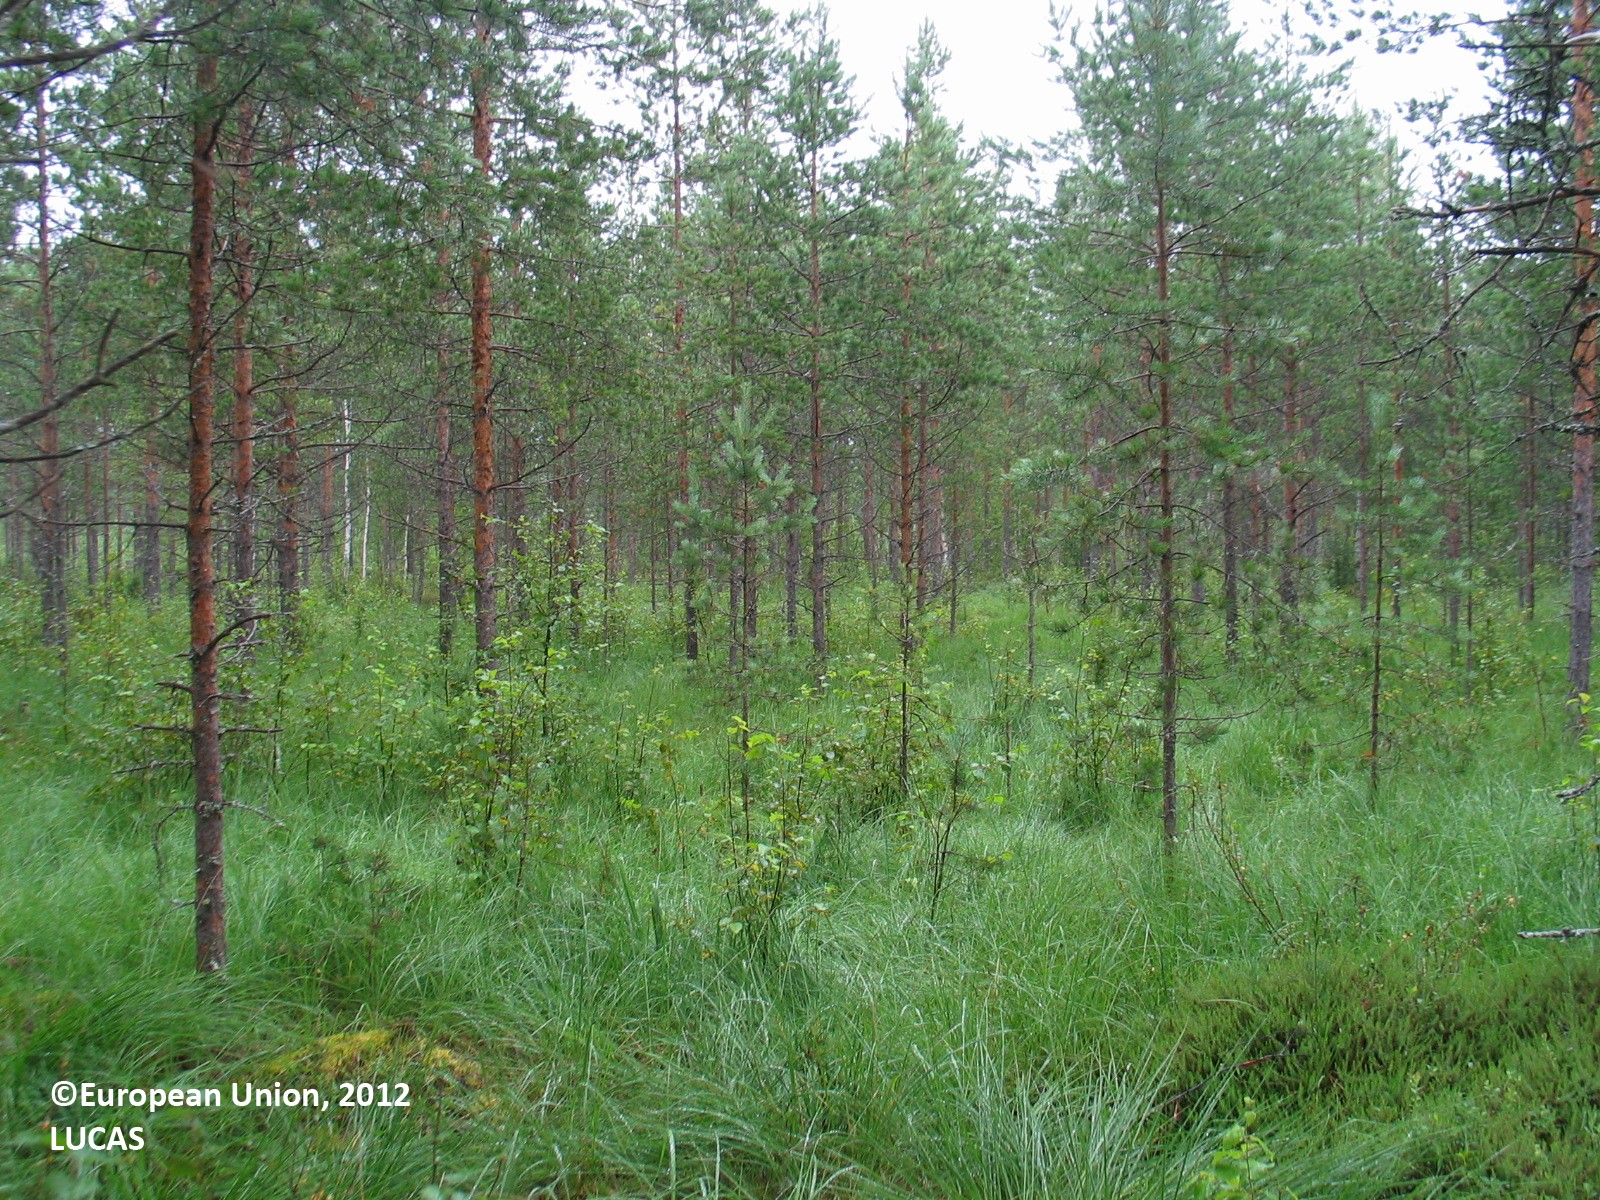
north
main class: Woodland
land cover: Pine dominated mixed woodland
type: mire and swamp forests
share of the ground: 25 - 50 %
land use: Forestry
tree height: > 5 m
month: August
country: FI
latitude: 64.5969
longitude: 25.9997
